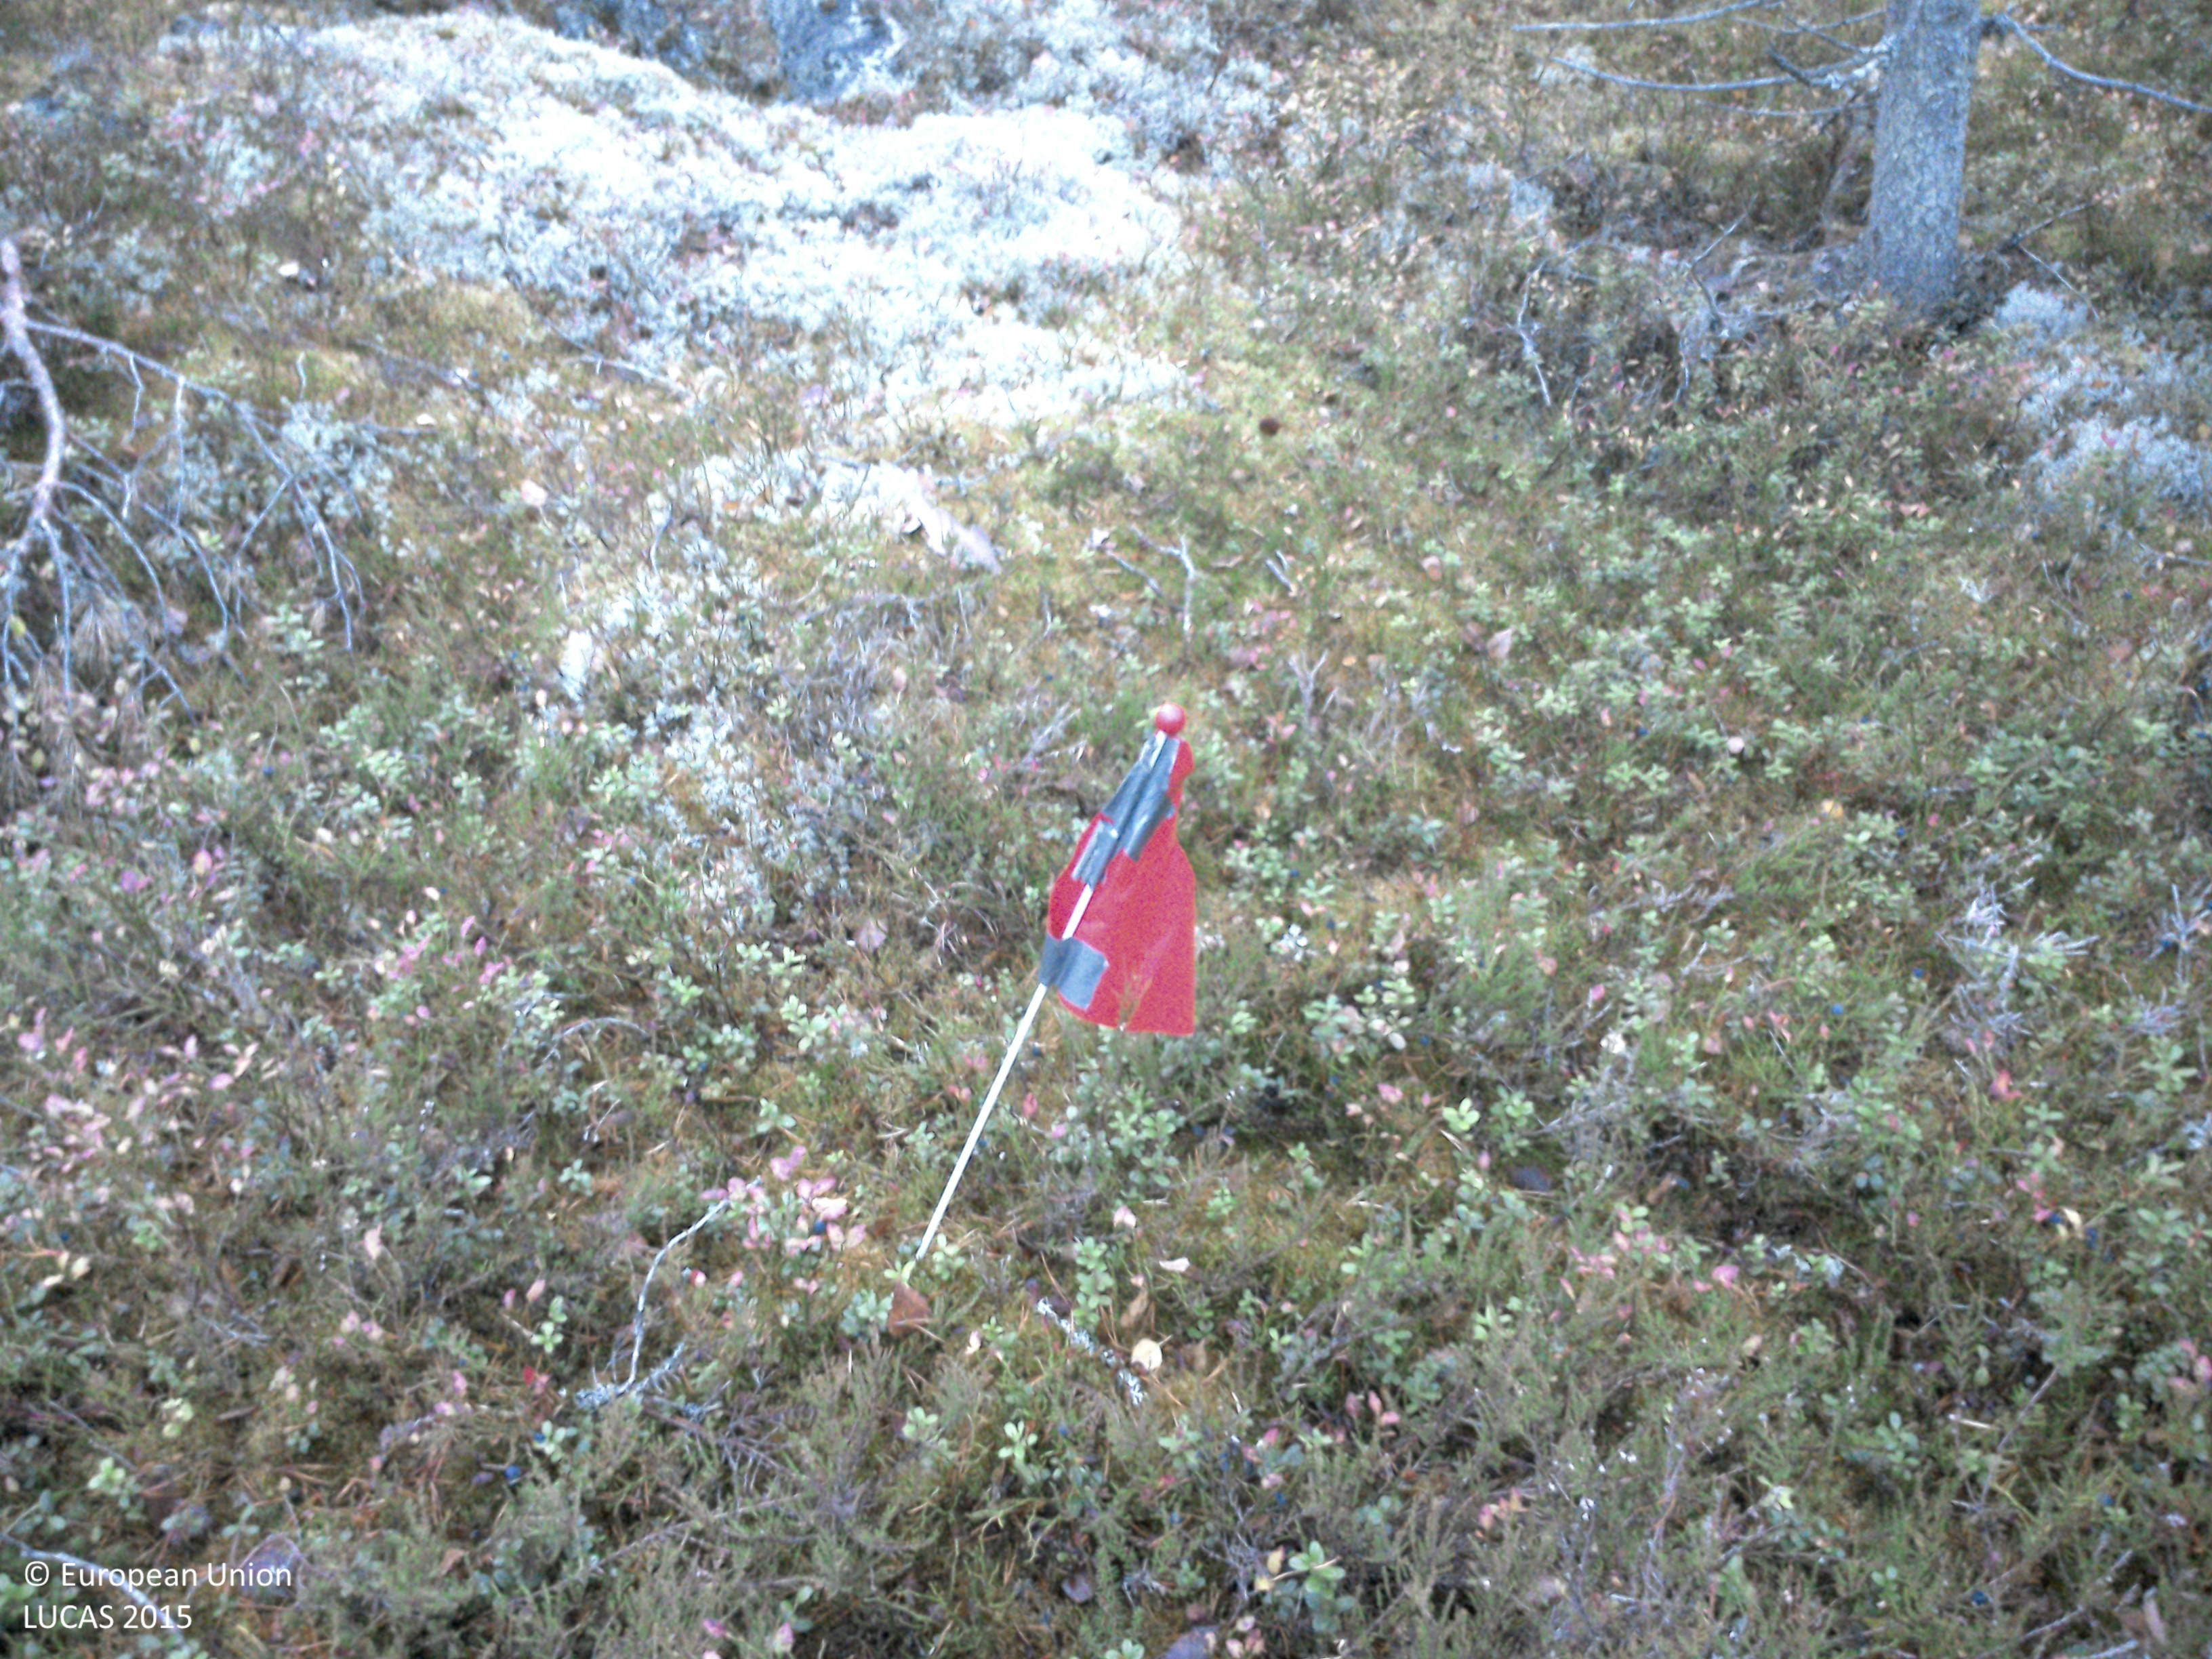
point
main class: Woodland
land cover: Other coniferous woodland
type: boreal forest
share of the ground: 50 - 75 %
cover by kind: coniferous forest trees 50 %, shrubs 50 %
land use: Forestry
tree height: > 5 m
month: October
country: SE
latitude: 63.8192
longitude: 19.8319
